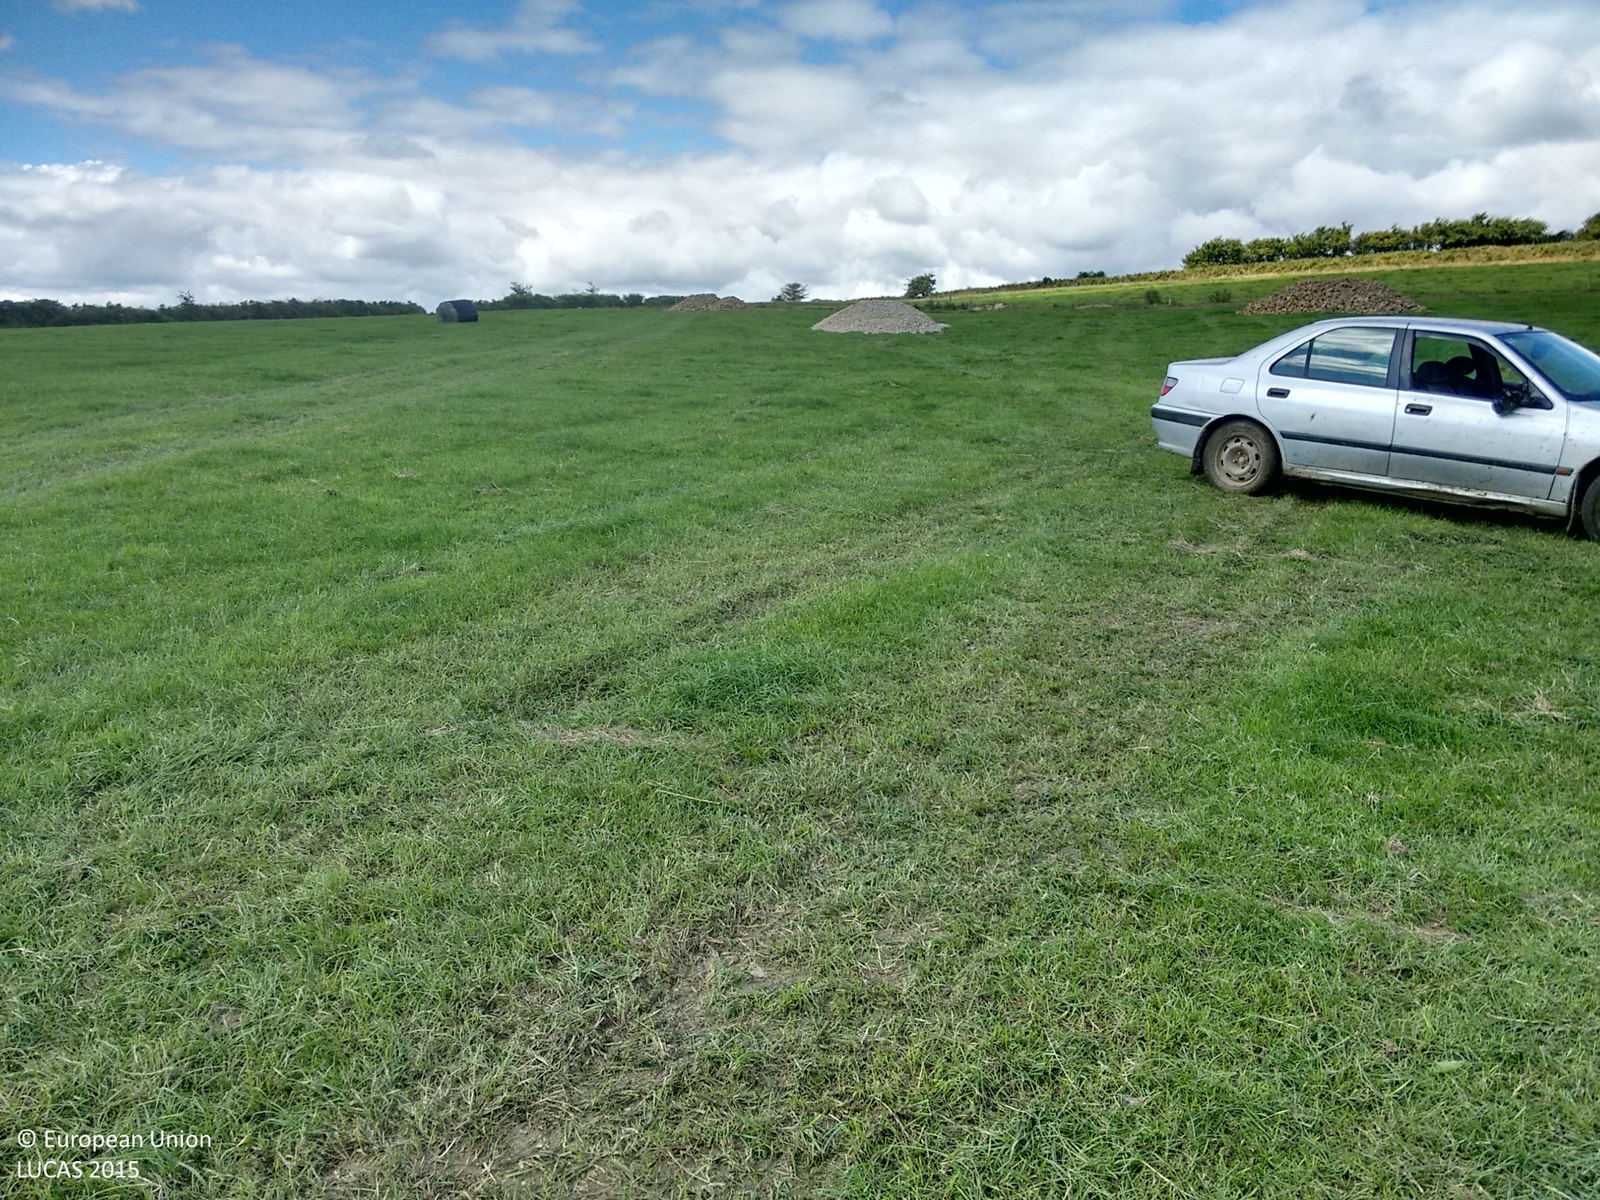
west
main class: Grassland
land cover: Grassland without tree/shrub cover
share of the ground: > 75 %
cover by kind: herbaceous plants 95 %, shrubs 5 %
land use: Agriculture (excluding fallow land and kitchen gardens)
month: July
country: IE
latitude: 52.2595
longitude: -8.9190
